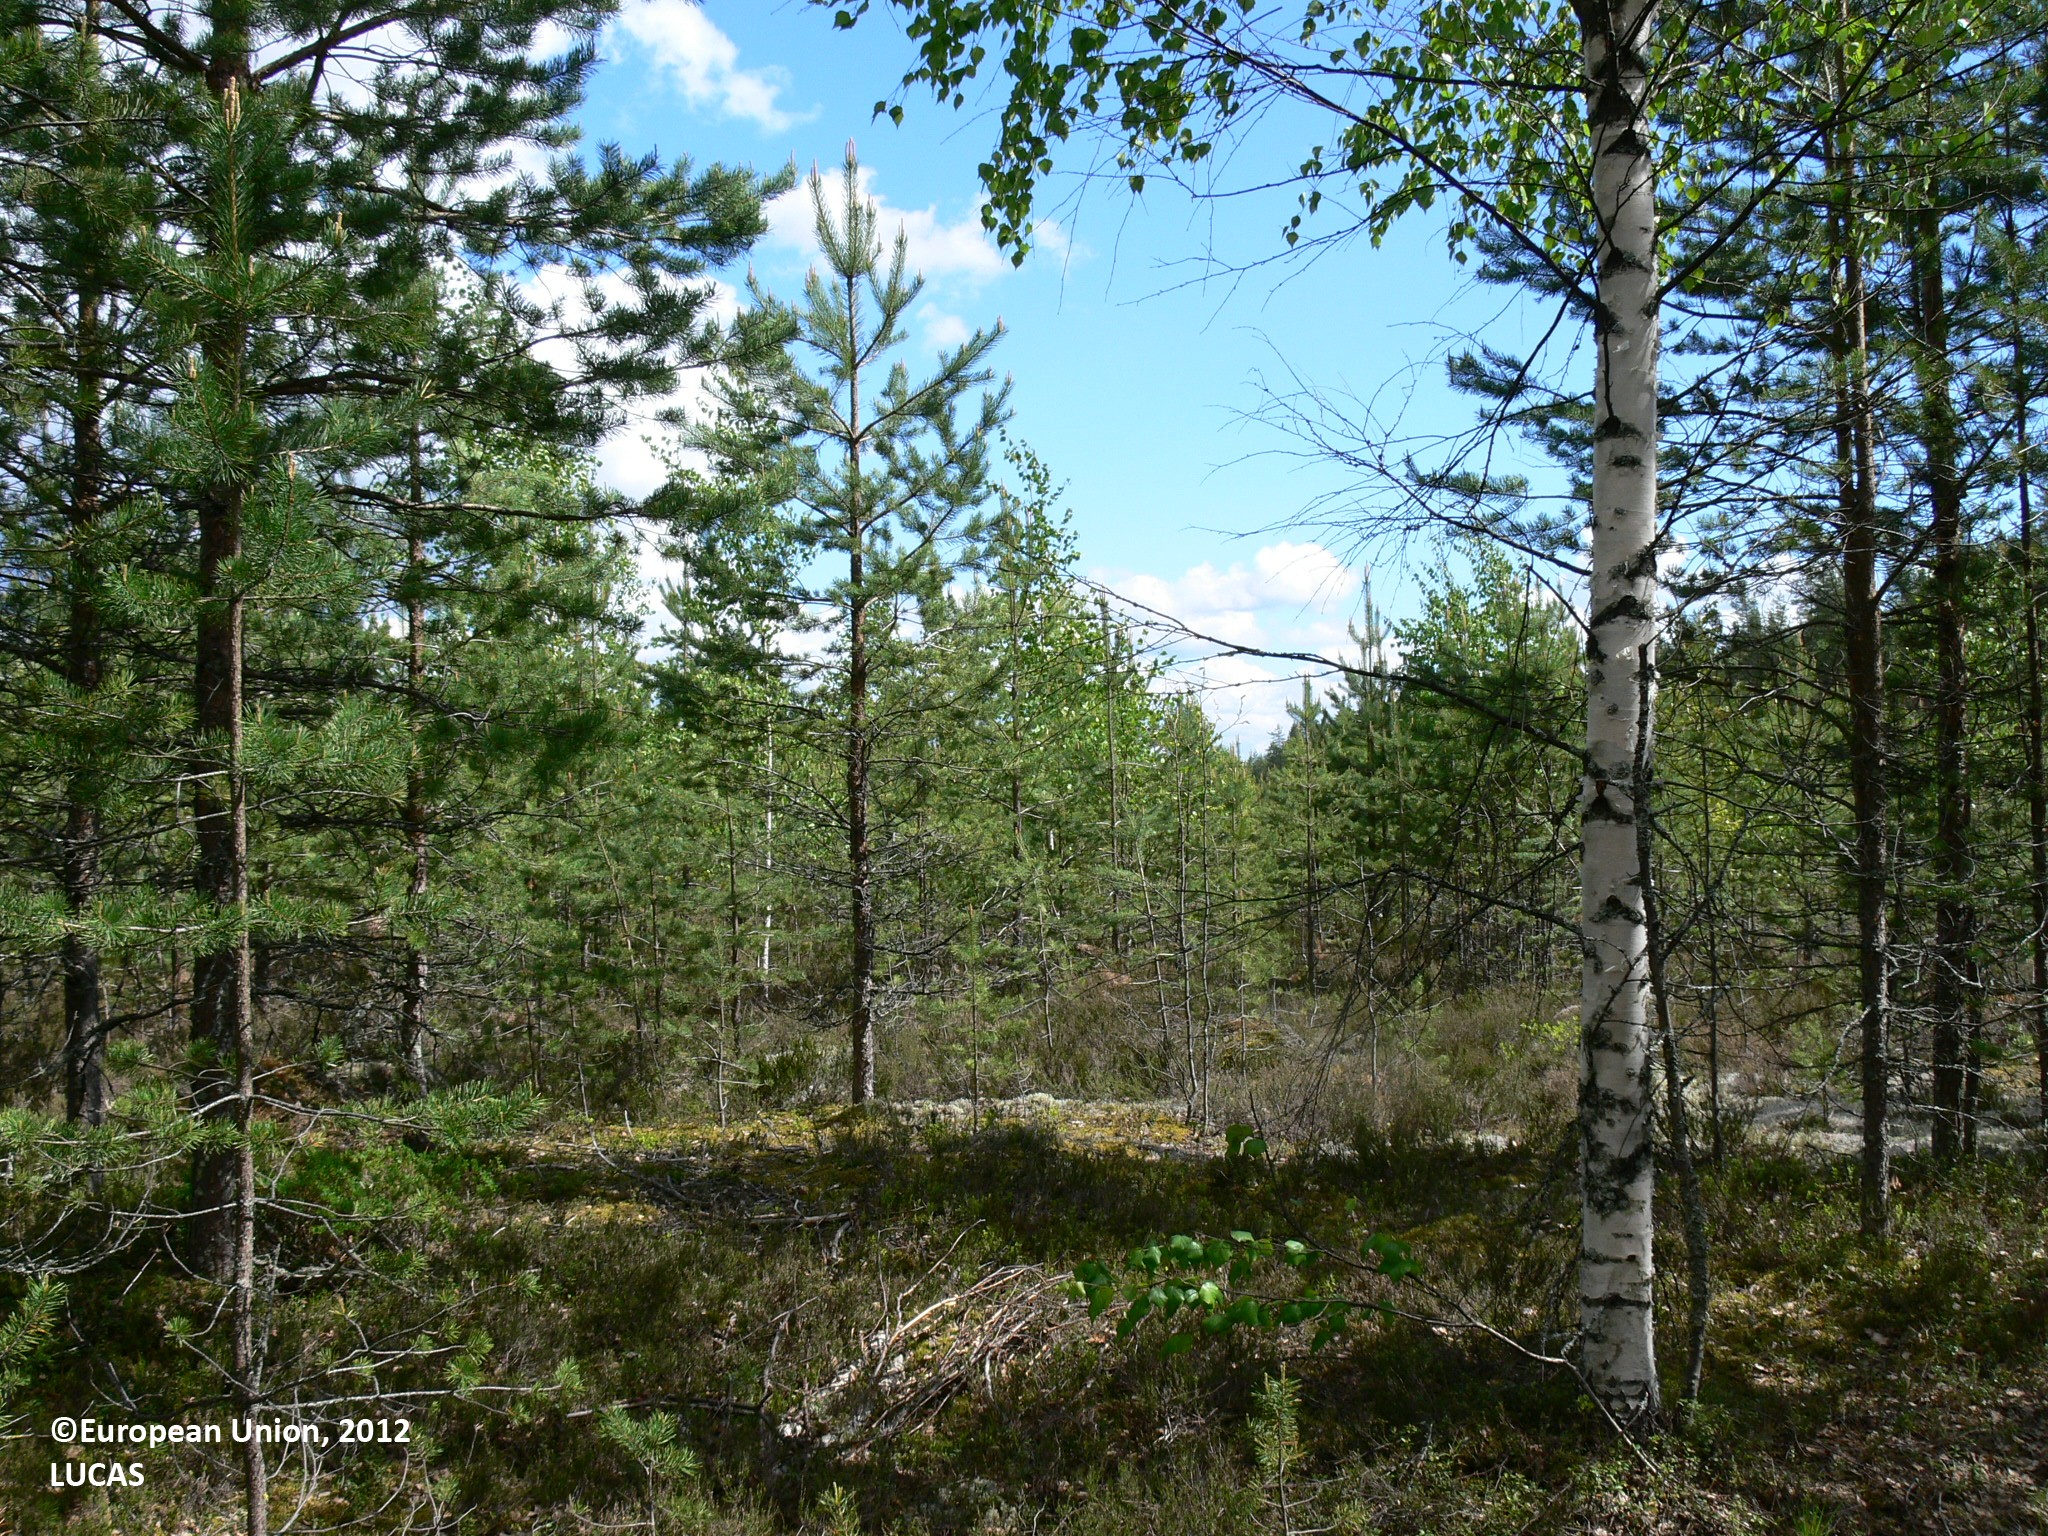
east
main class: Woodland
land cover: Pine dominated mixed woodland
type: boreal forest
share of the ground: > 75 %
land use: Forestry
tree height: < 5 m
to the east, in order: Tracks; Pine dominated mixed woodland; Pine dominated coniferous woodland
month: June
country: FI
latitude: 62.6834
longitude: 29.7611
